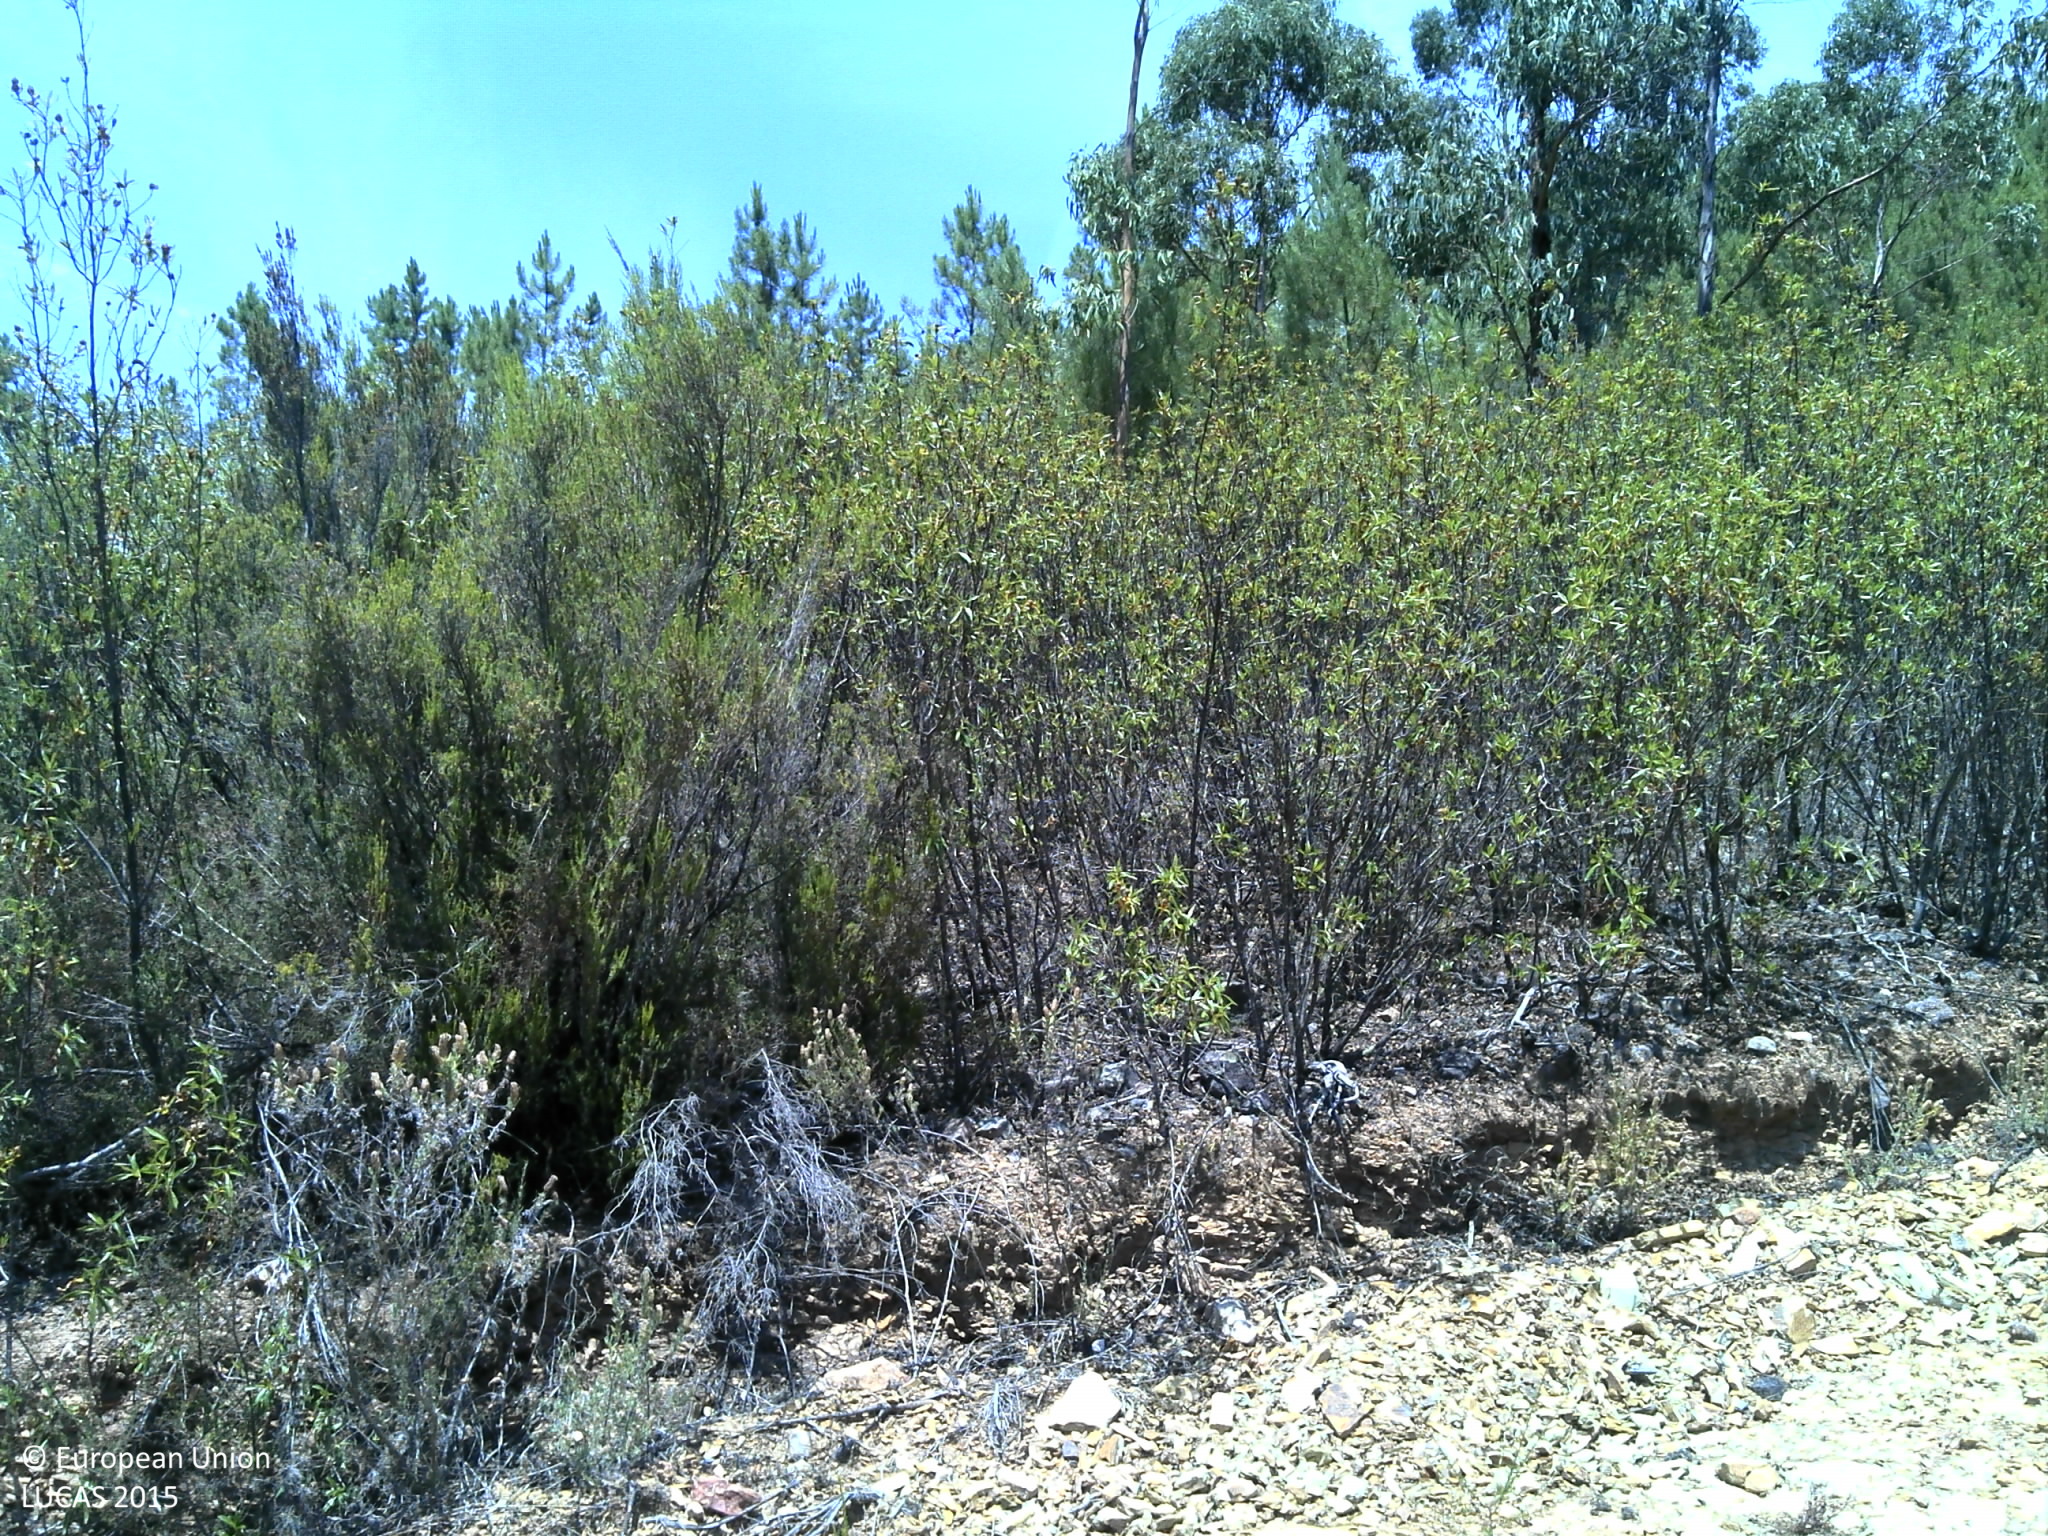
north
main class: Shrubland
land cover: Shrubland with sparse tree cover
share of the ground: > 75 %
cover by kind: shrubs 80 %, unconsolidated bare surface 15 %, coniferous forest trees 5 %
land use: Semi-natural and natural areas not in use
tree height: > 5 m
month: July
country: PT
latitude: 39.5972
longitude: -7.9347
